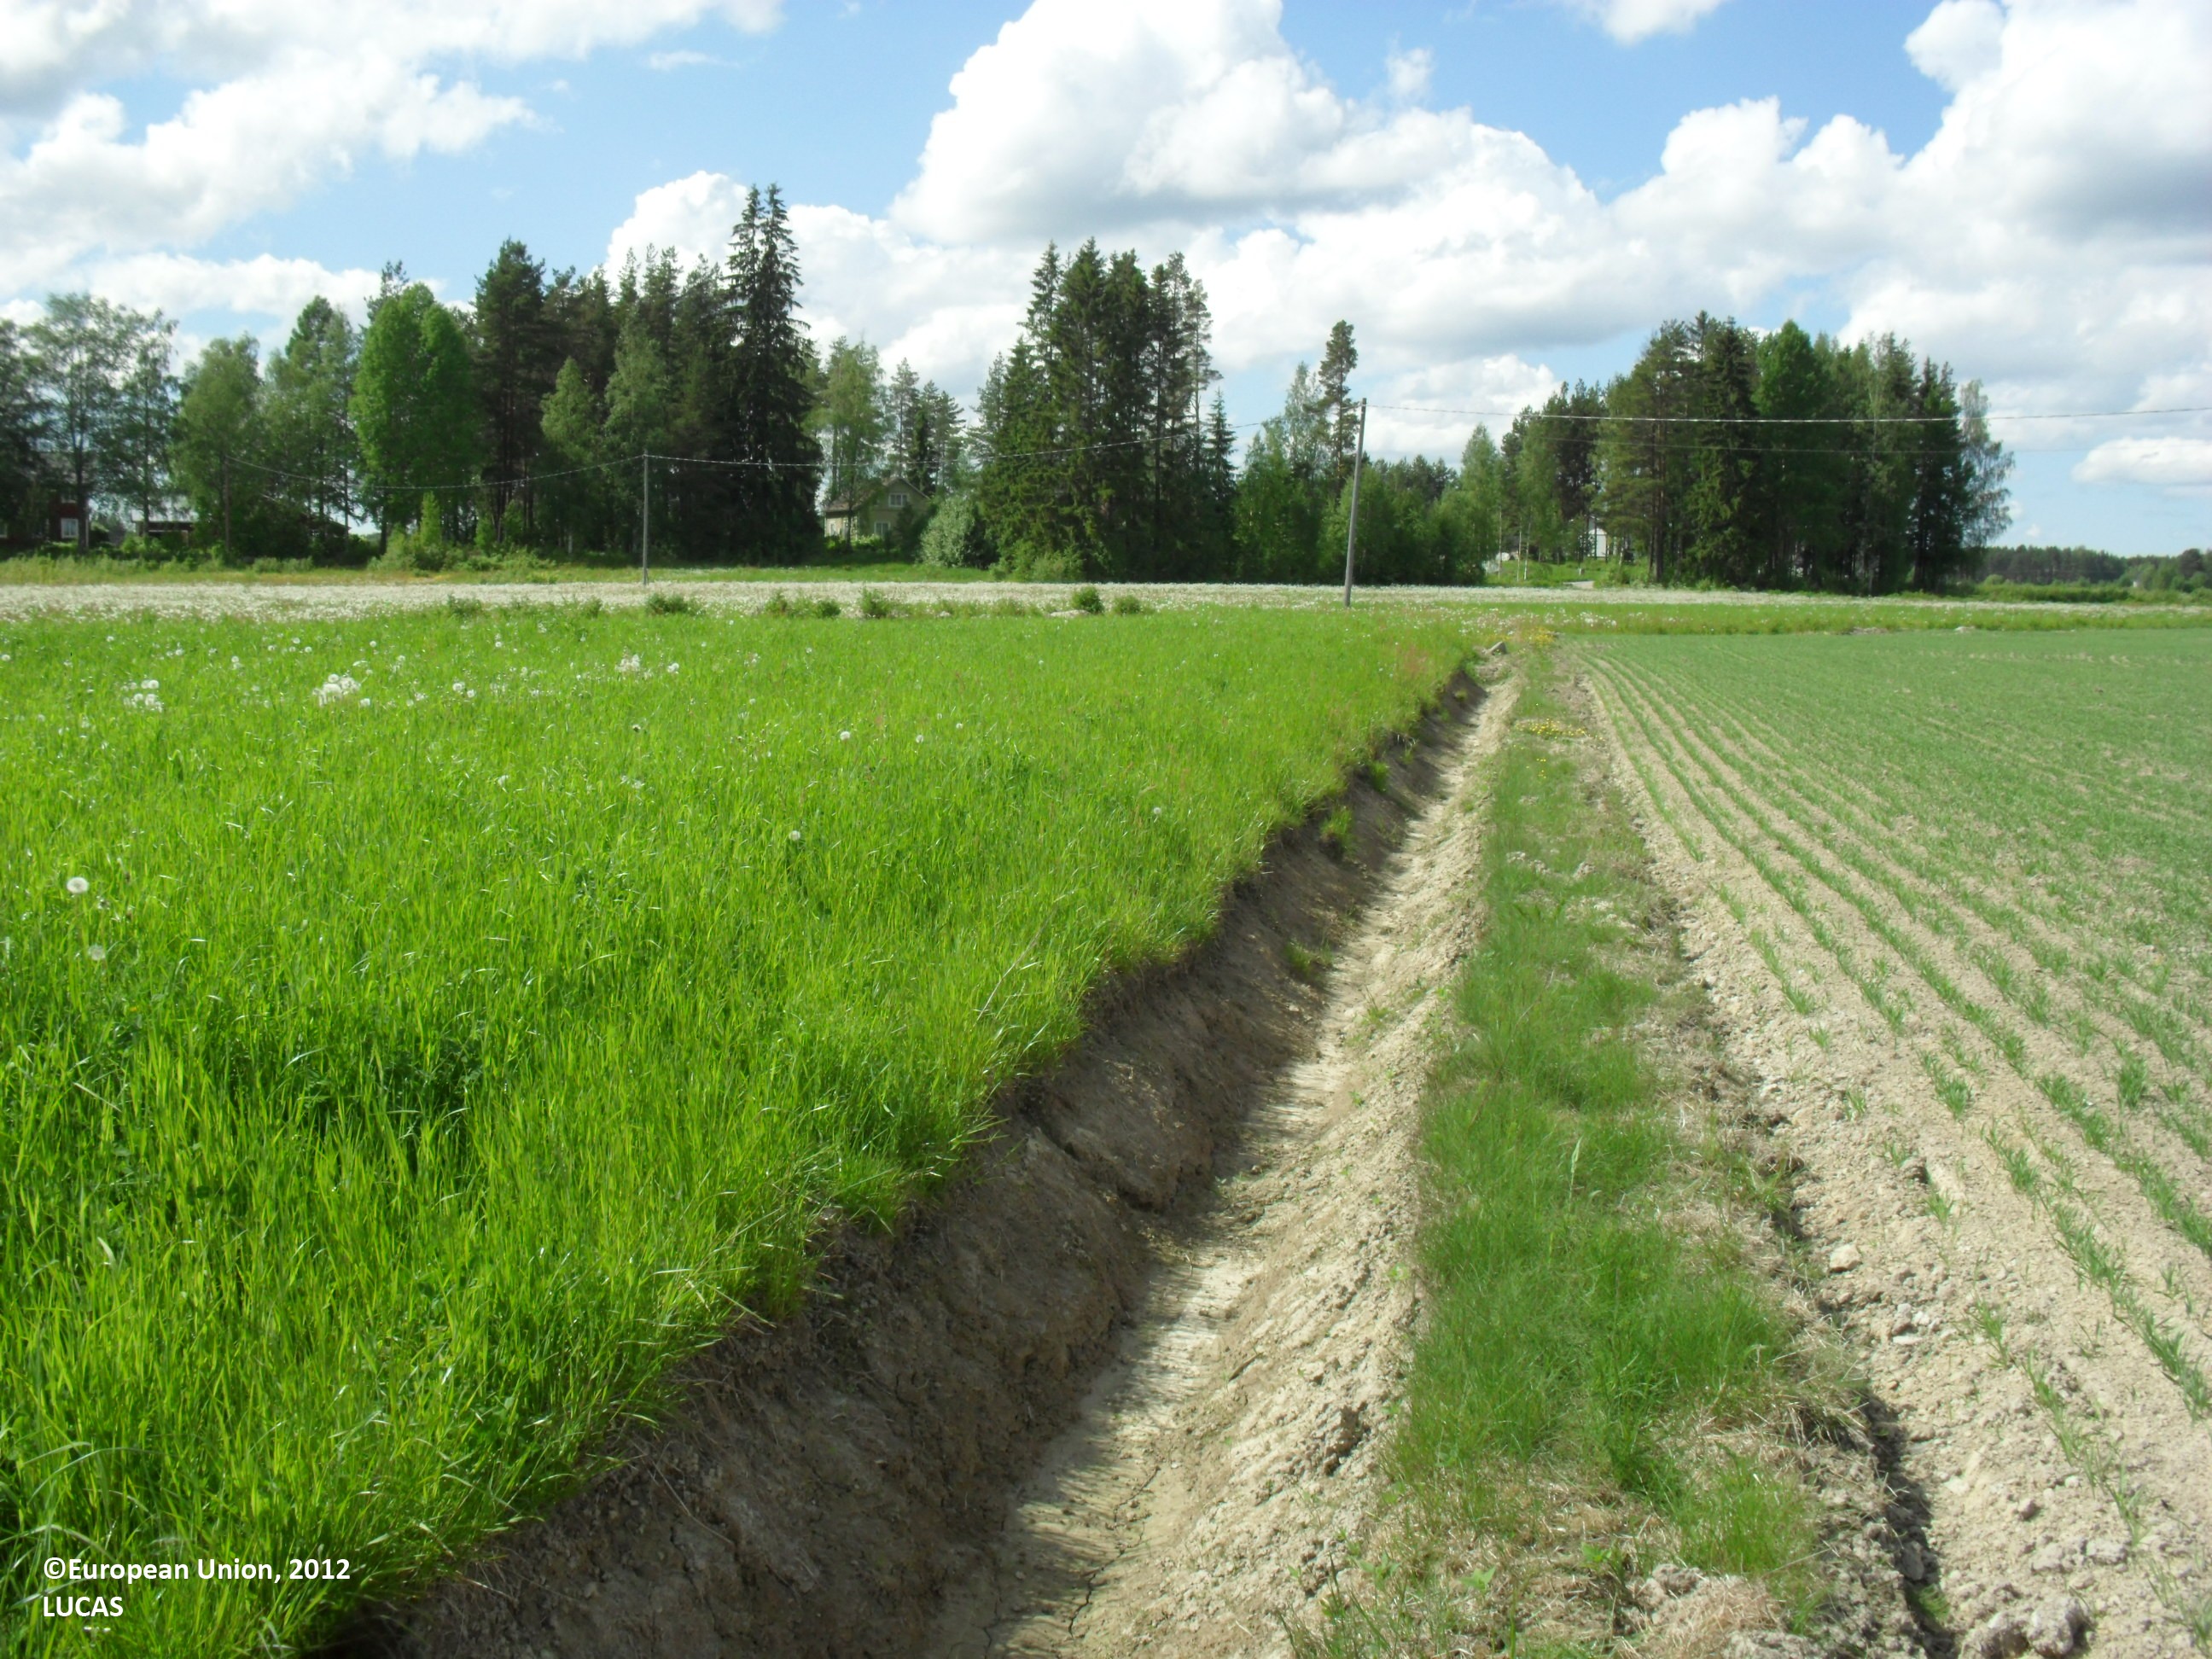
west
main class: Cropland
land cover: Barley
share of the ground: < 10 %
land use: Agriculture (excluding fallow land and kitchen gardens)
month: June
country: FI
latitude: 62.8463
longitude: 23.4822
